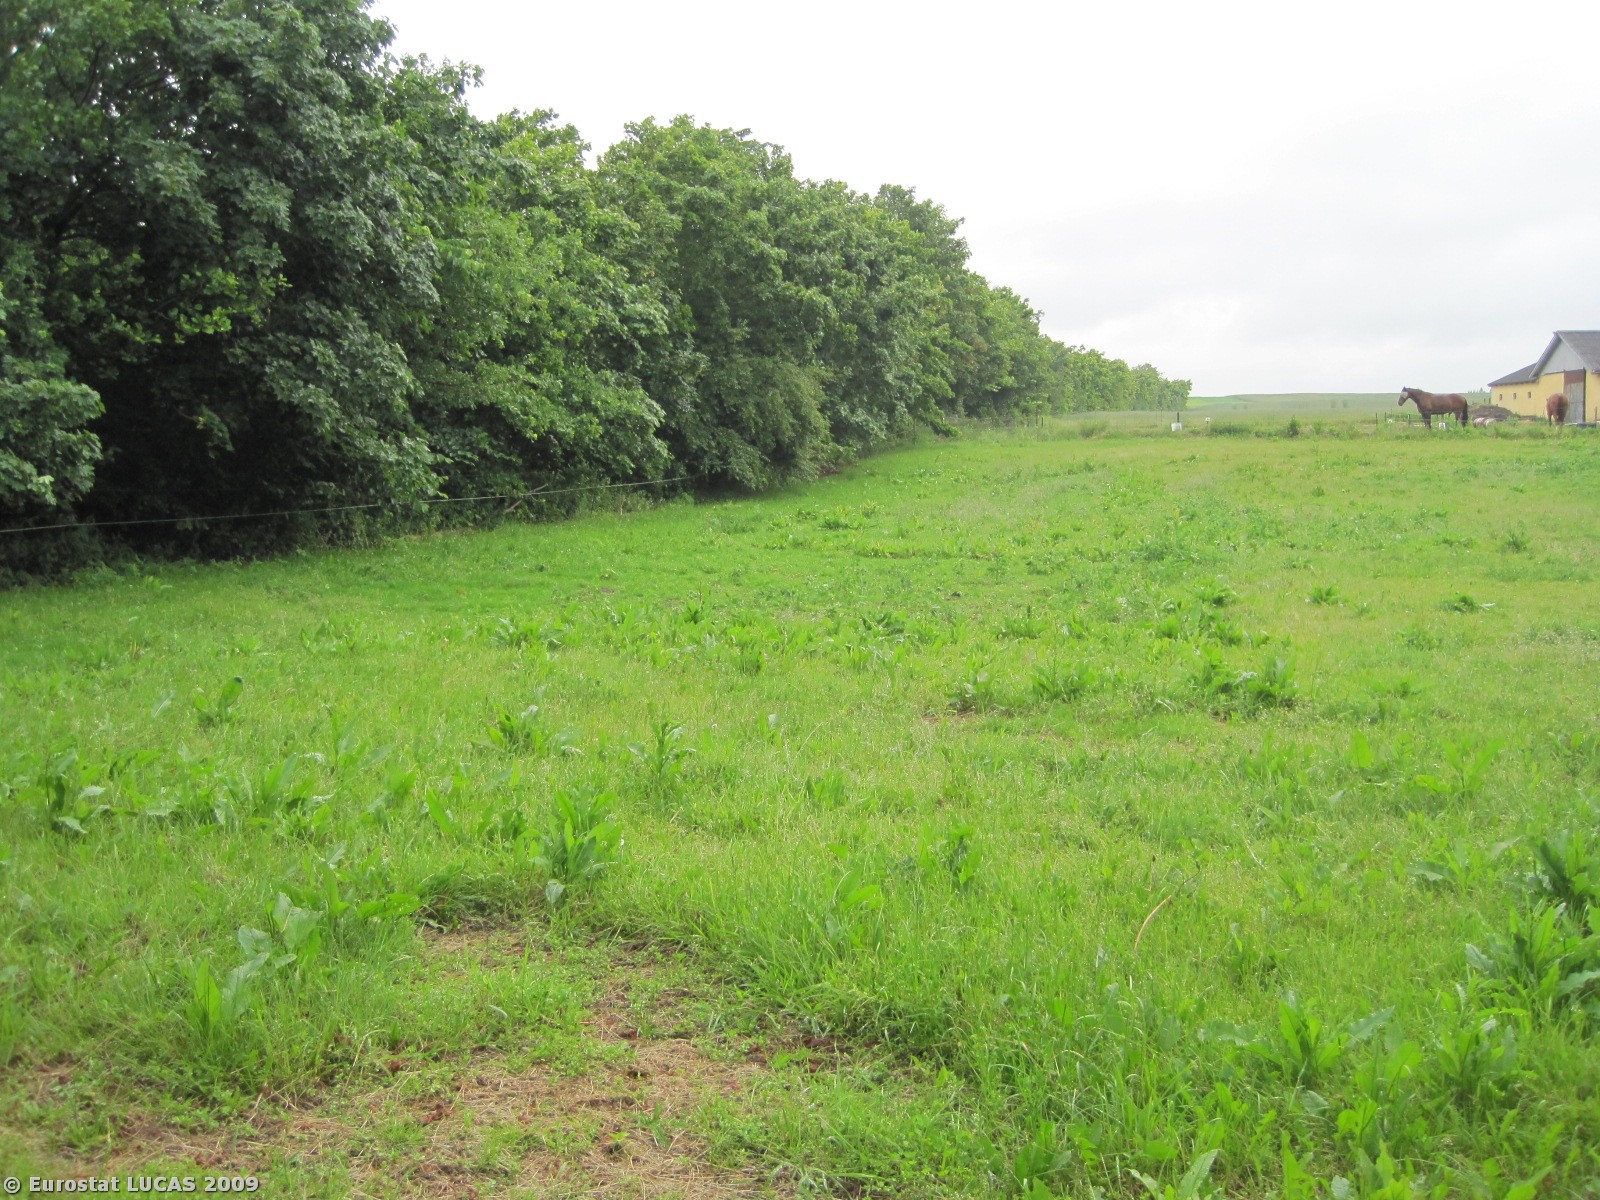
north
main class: Woodland
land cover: Mixed woodland
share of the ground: > 75 %
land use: Unused
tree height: > 5 m
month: June
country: DK
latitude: 57.5179
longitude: 10.2500
